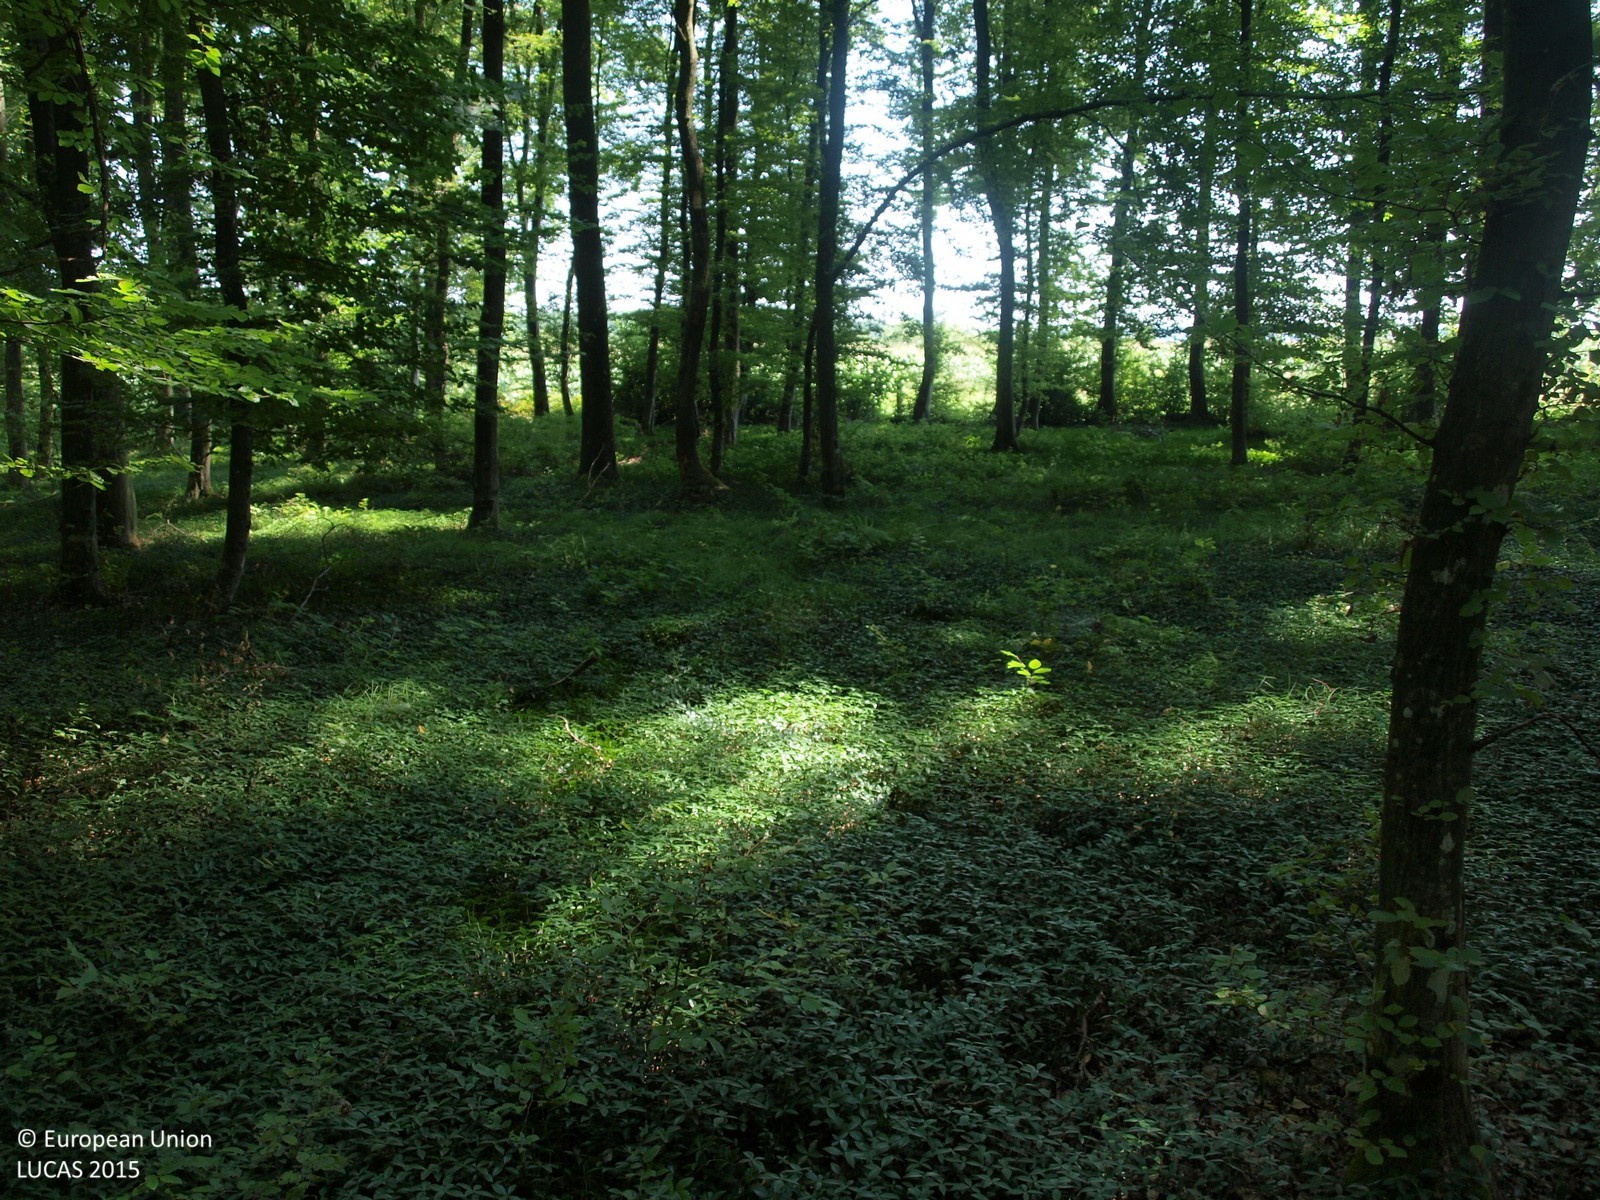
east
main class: Woodland
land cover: Broadleaved woodland
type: mesophytic deciduous forest
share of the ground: > 75 %
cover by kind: broadleaved forest trees 100 %
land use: Forestry
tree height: > 5 m
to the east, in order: Broadleaved woodland; Fences; Maize; Permanent crops (only in case pi)
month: August
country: HR
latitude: 45.8757
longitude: 16.6090
